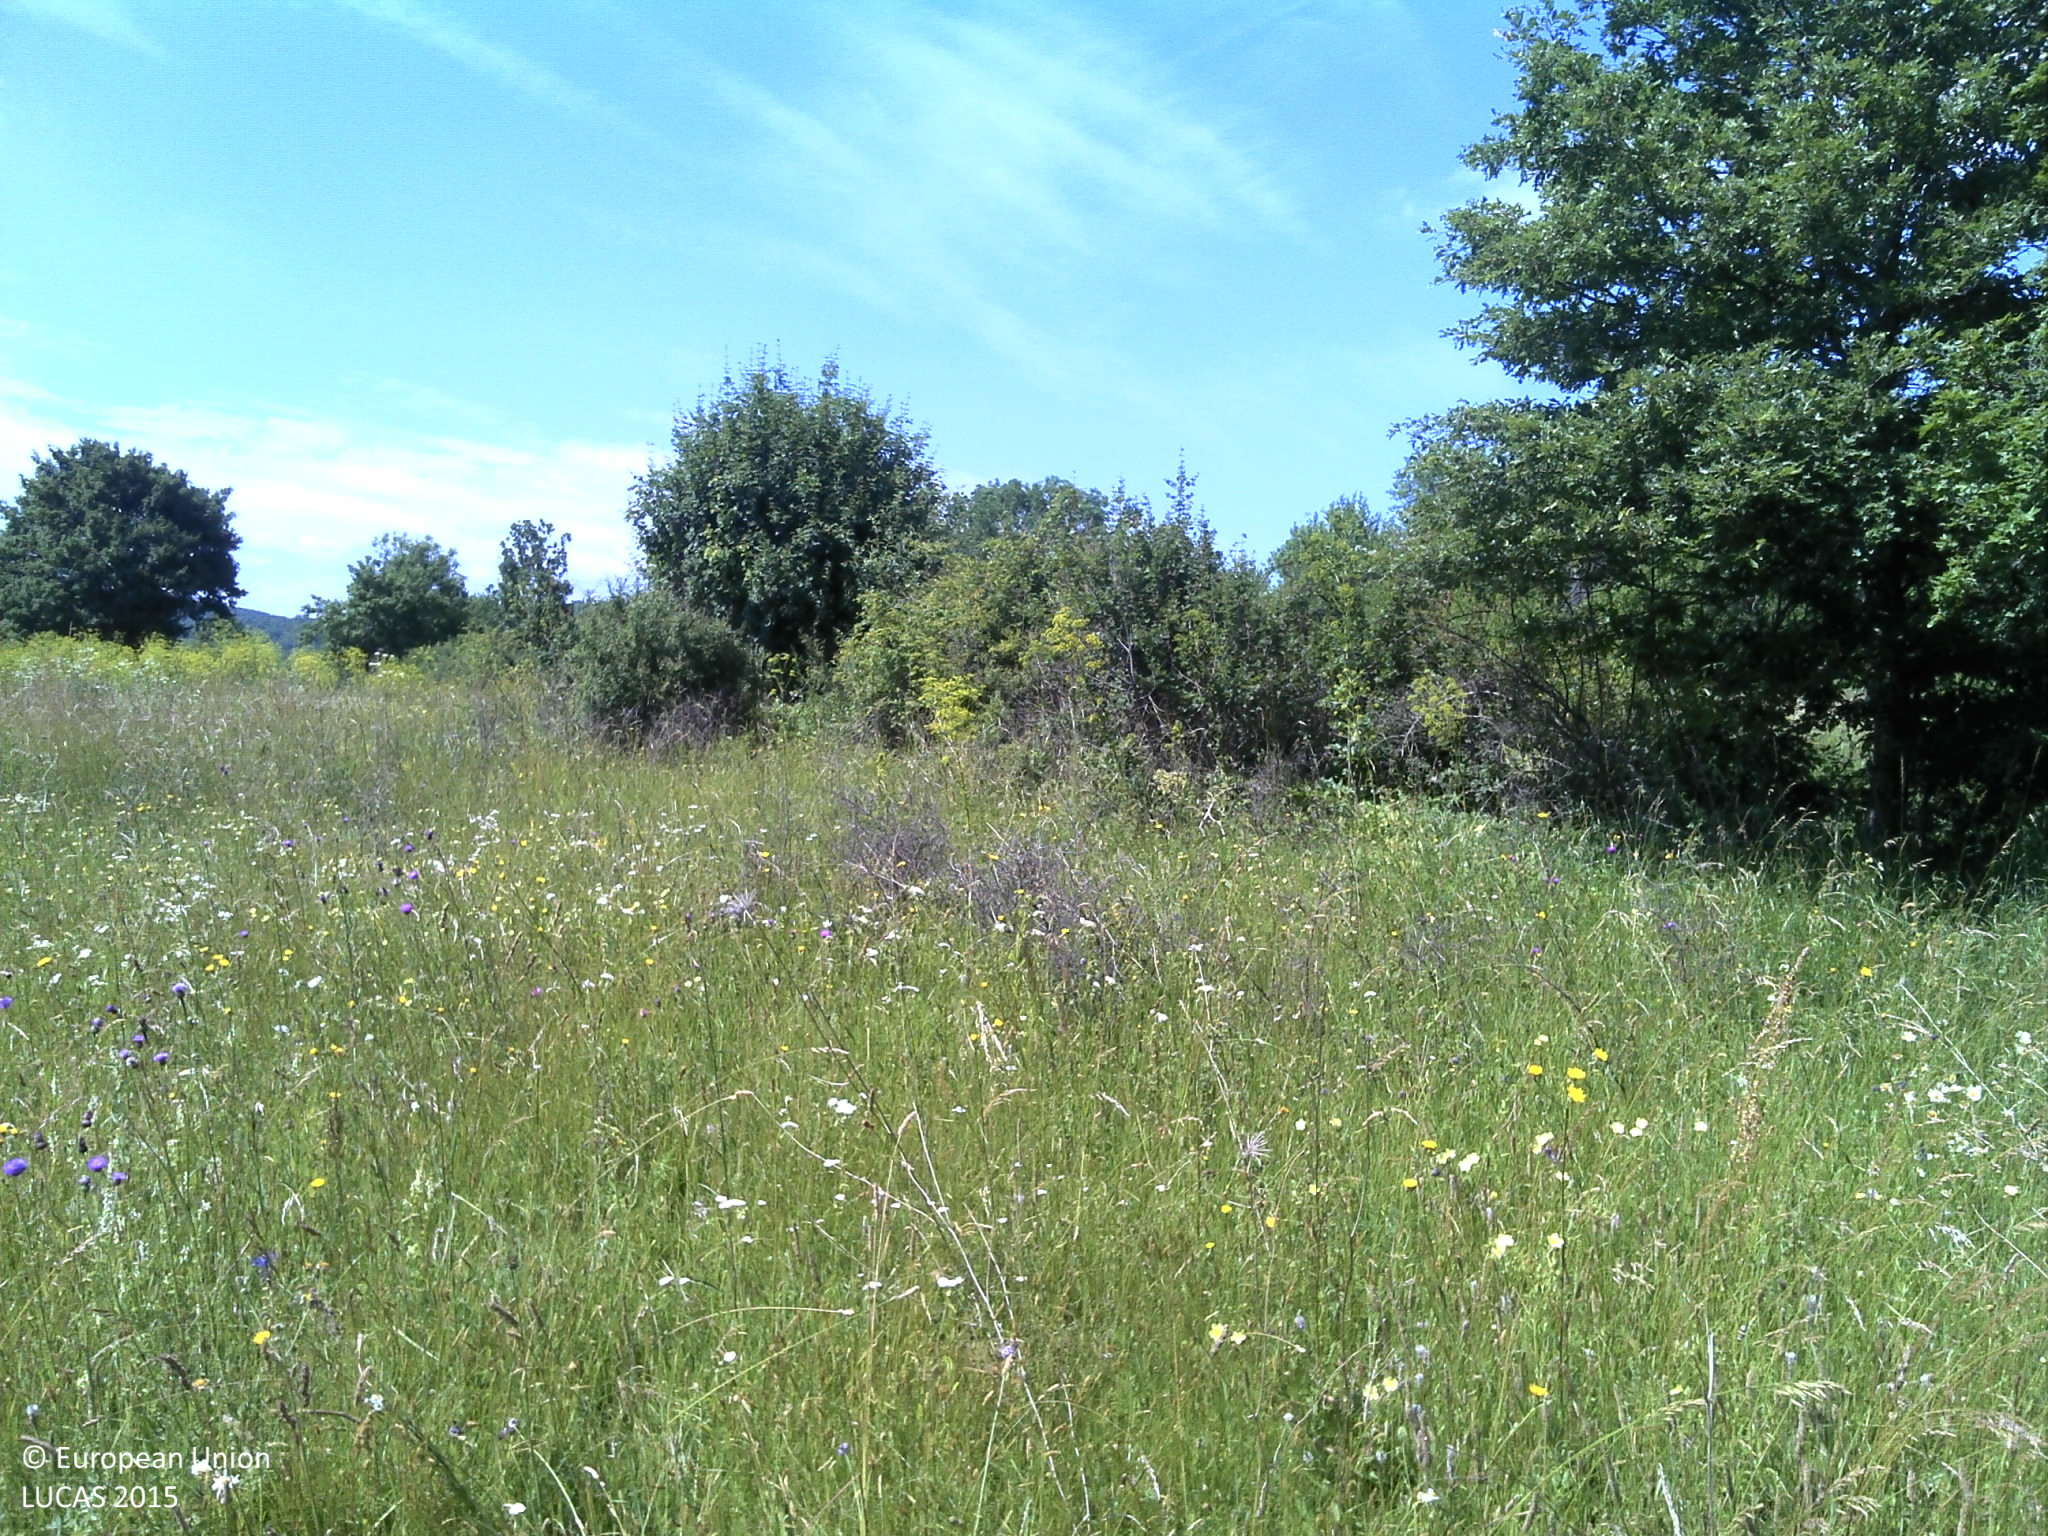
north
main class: Woodland
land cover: Broadleaved woodland
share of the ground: 10 - 25 %
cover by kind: herbaceous plants 80 %, broadleaved forest trees 20 %
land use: Abandoned areas
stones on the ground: < 10 %
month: June
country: HR
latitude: 44.4491
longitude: 15.6606
